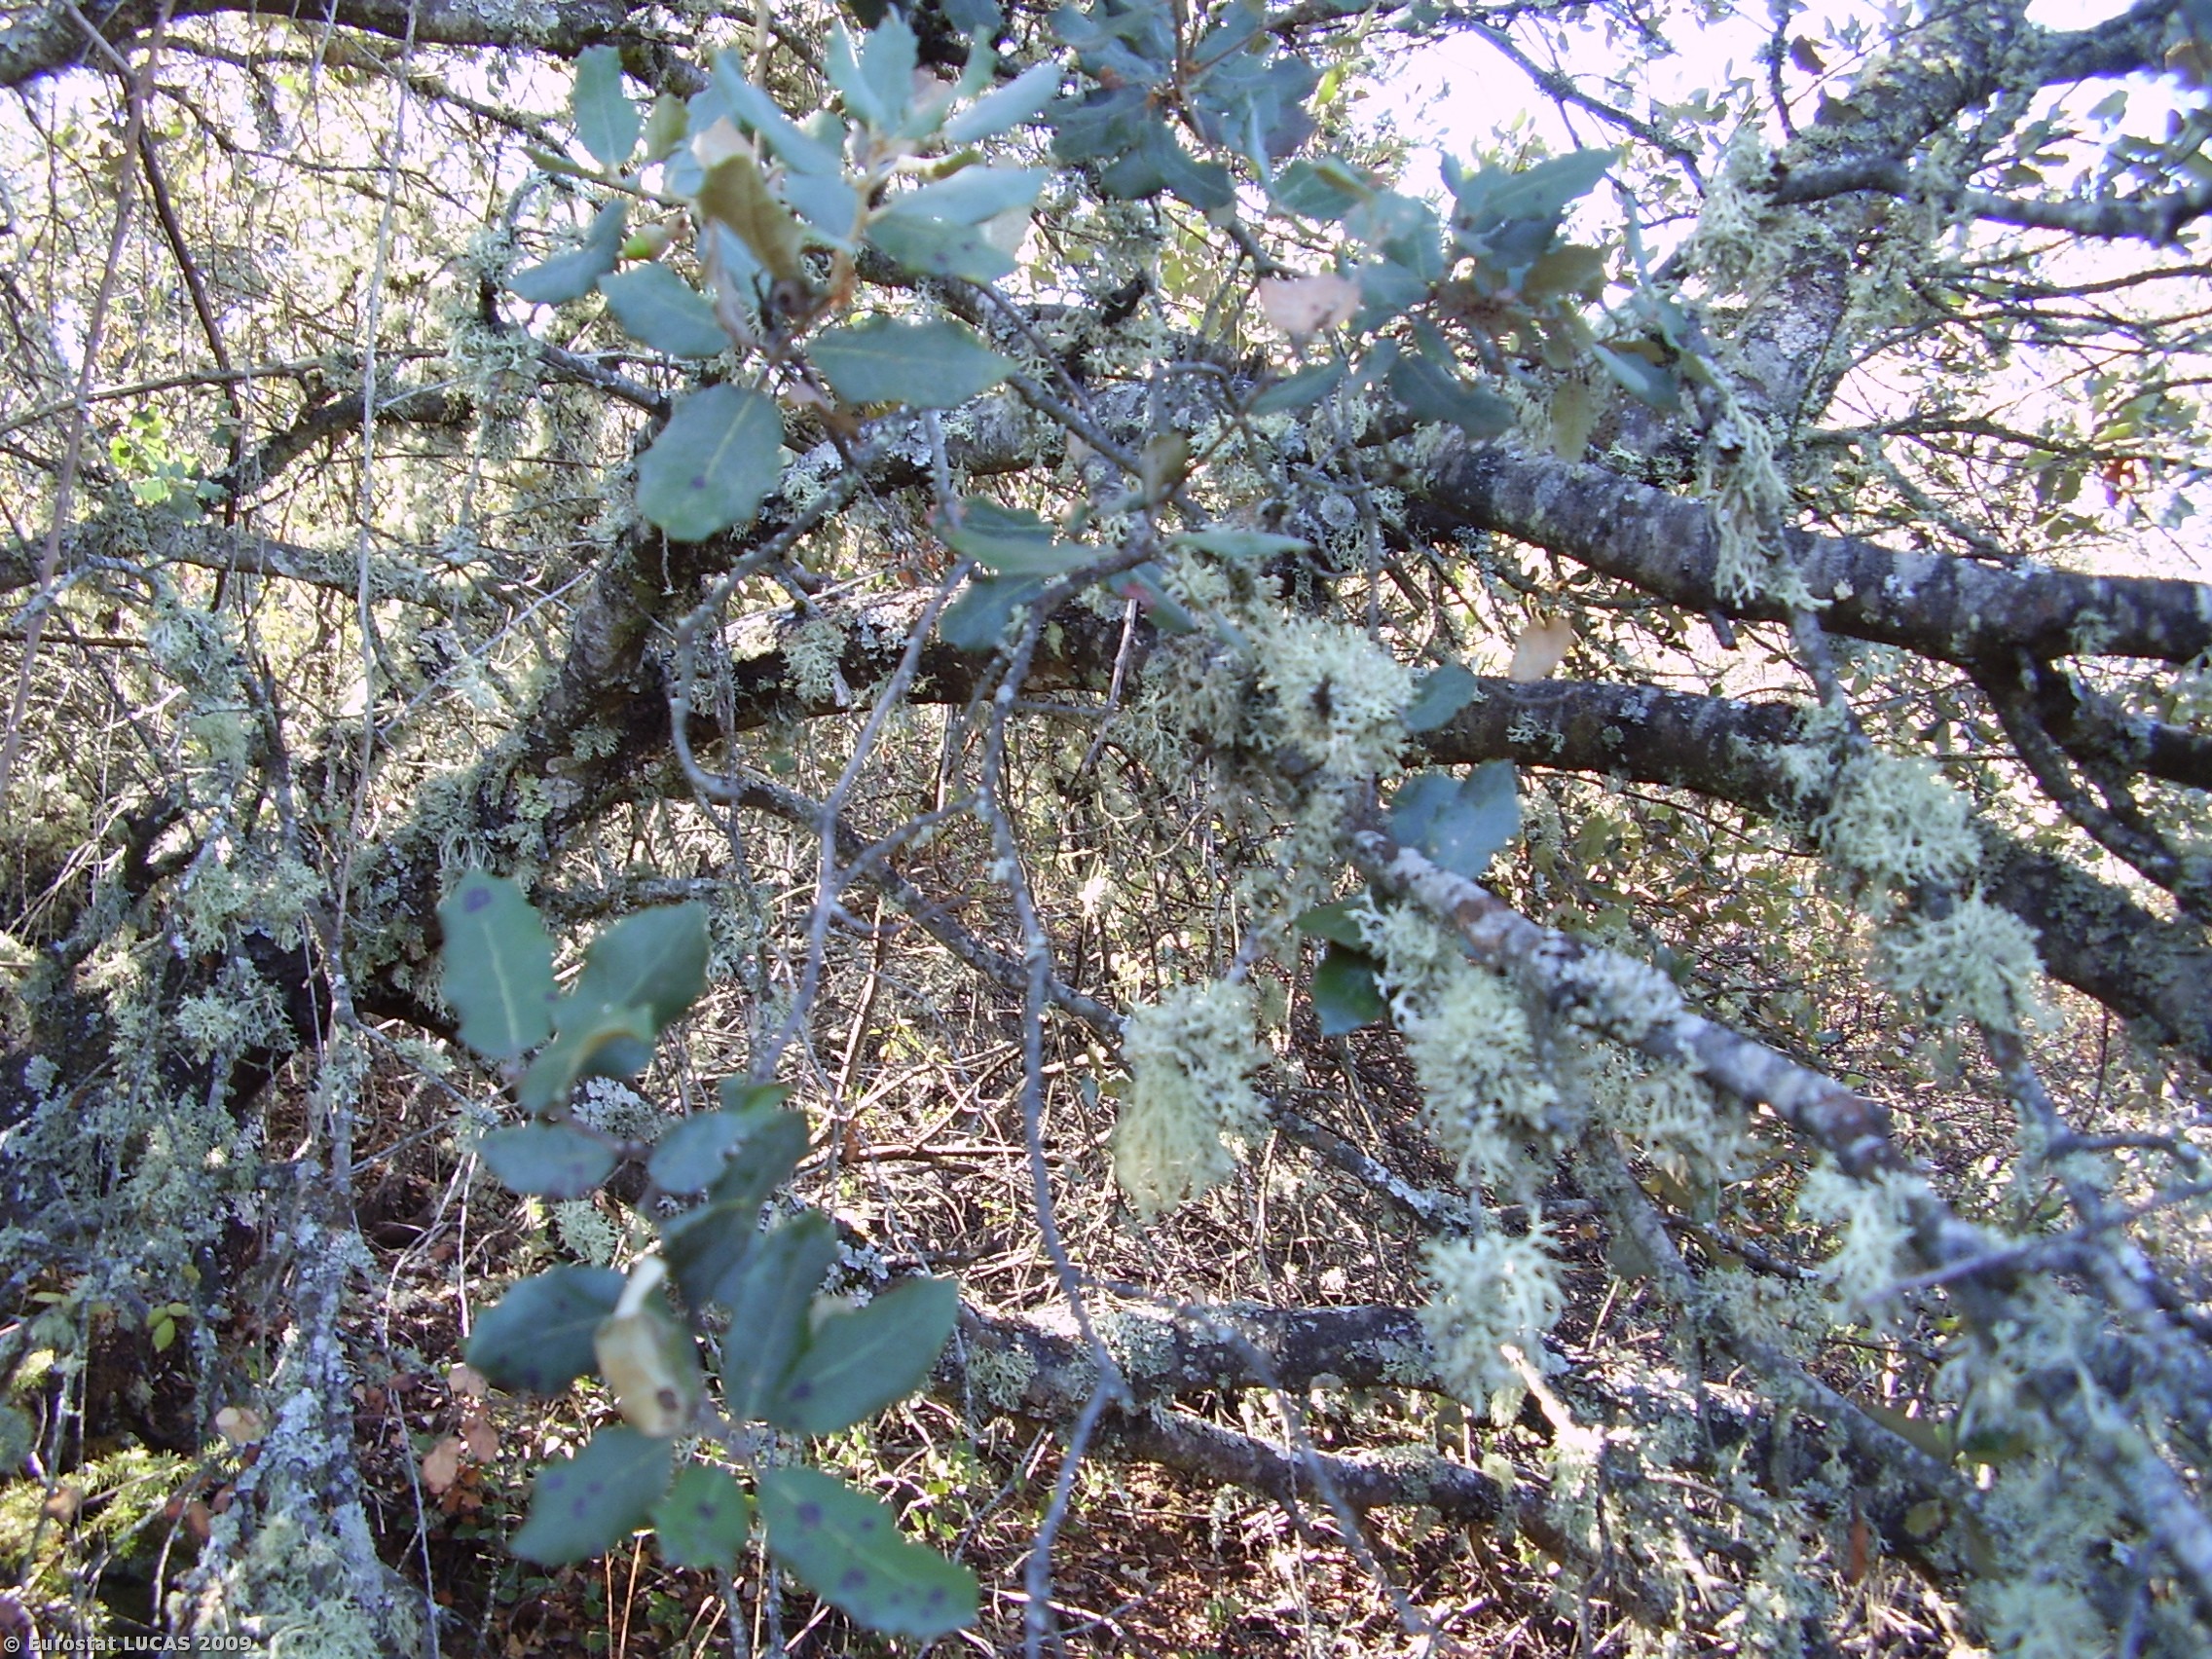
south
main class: Woodland
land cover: Broadleaved woodland
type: broadleaved evergreen forest
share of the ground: 10 - 25 %
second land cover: Shrubland with sparse tree cover
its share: > 75 %
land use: Forestry
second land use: Fallow land
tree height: > 5 m
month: August
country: PT
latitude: 41.3958
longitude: -6.7436
